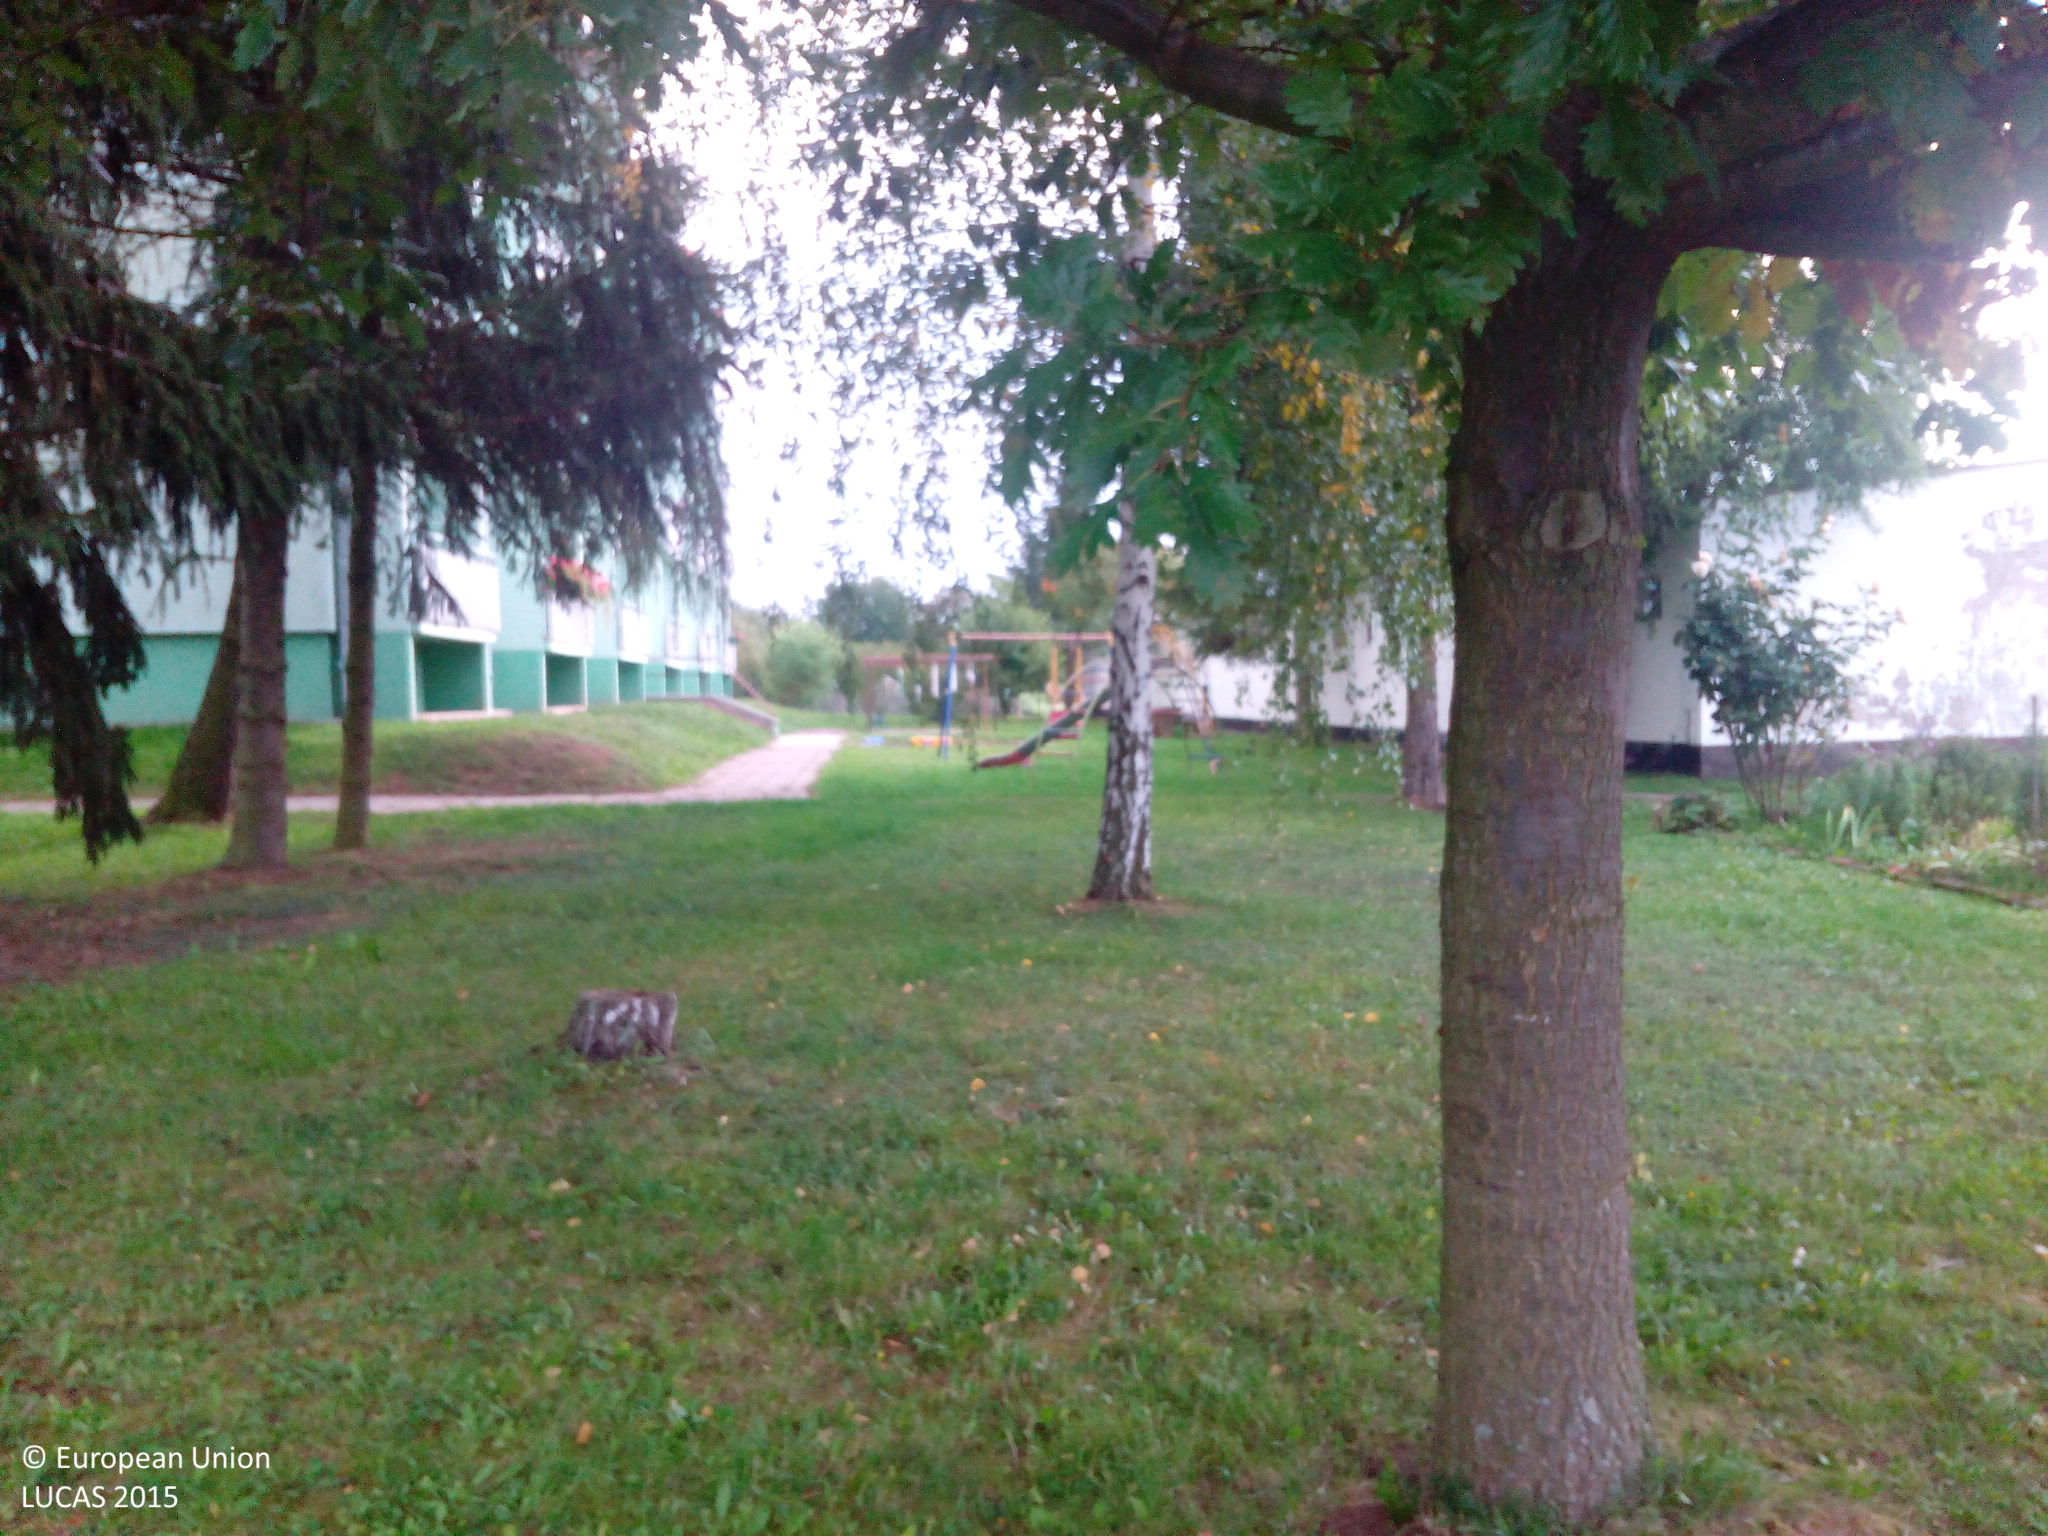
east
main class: Grassland
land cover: Grassland without tree/shrub cover
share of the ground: > 75 %
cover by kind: herbaceous plants 100 %
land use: Agriculture (excluding fallow land and kitchen gardens)
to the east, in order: Fences; Grassland without tree/shrub cover; Broadleaved woodland; Artificial constructions in urban areas; Grassland without tree/shrub cover; Potatoes
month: September
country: DE
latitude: 51.4570
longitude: 10.9352
